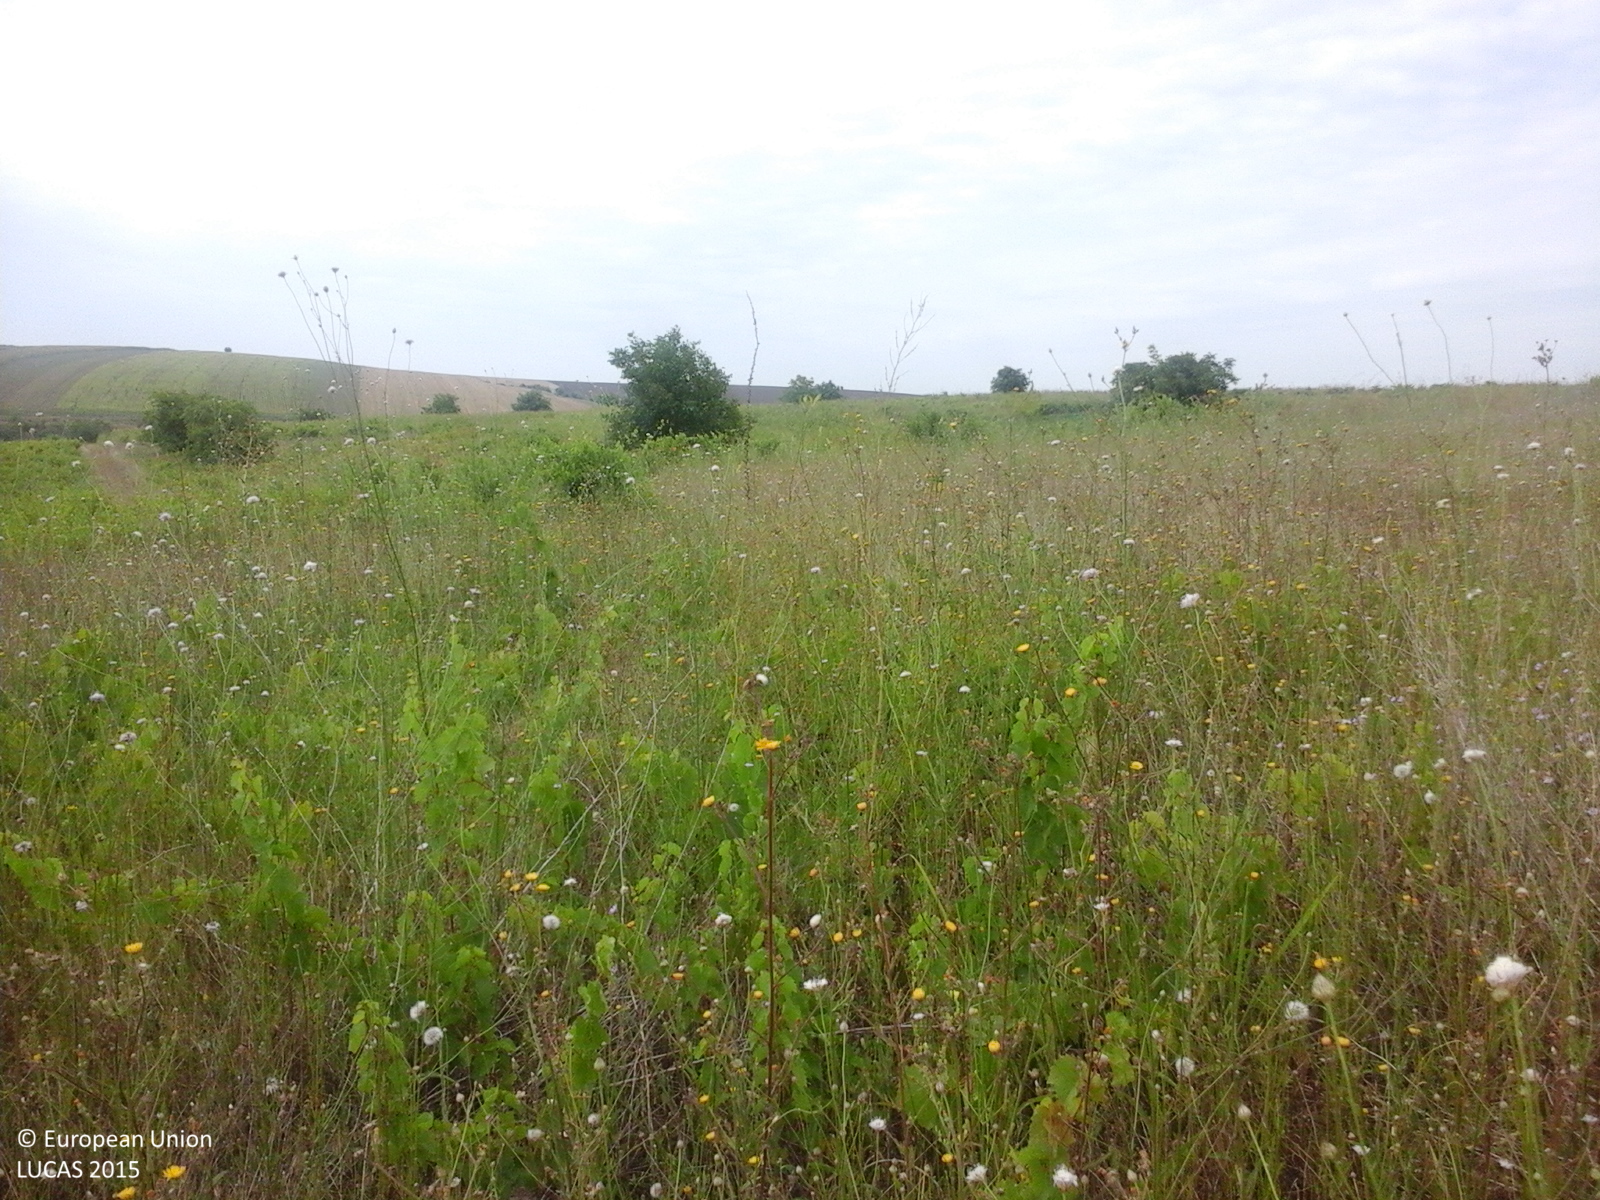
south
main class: Cropland
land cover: Vineyards
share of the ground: 25 - 50 %
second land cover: Spontaneously vegetated surfaces
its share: > 75 %
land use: Agriculture (excluding fallow land and kitchen gardens)
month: August
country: RO
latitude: 44.0699
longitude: 27.6855
